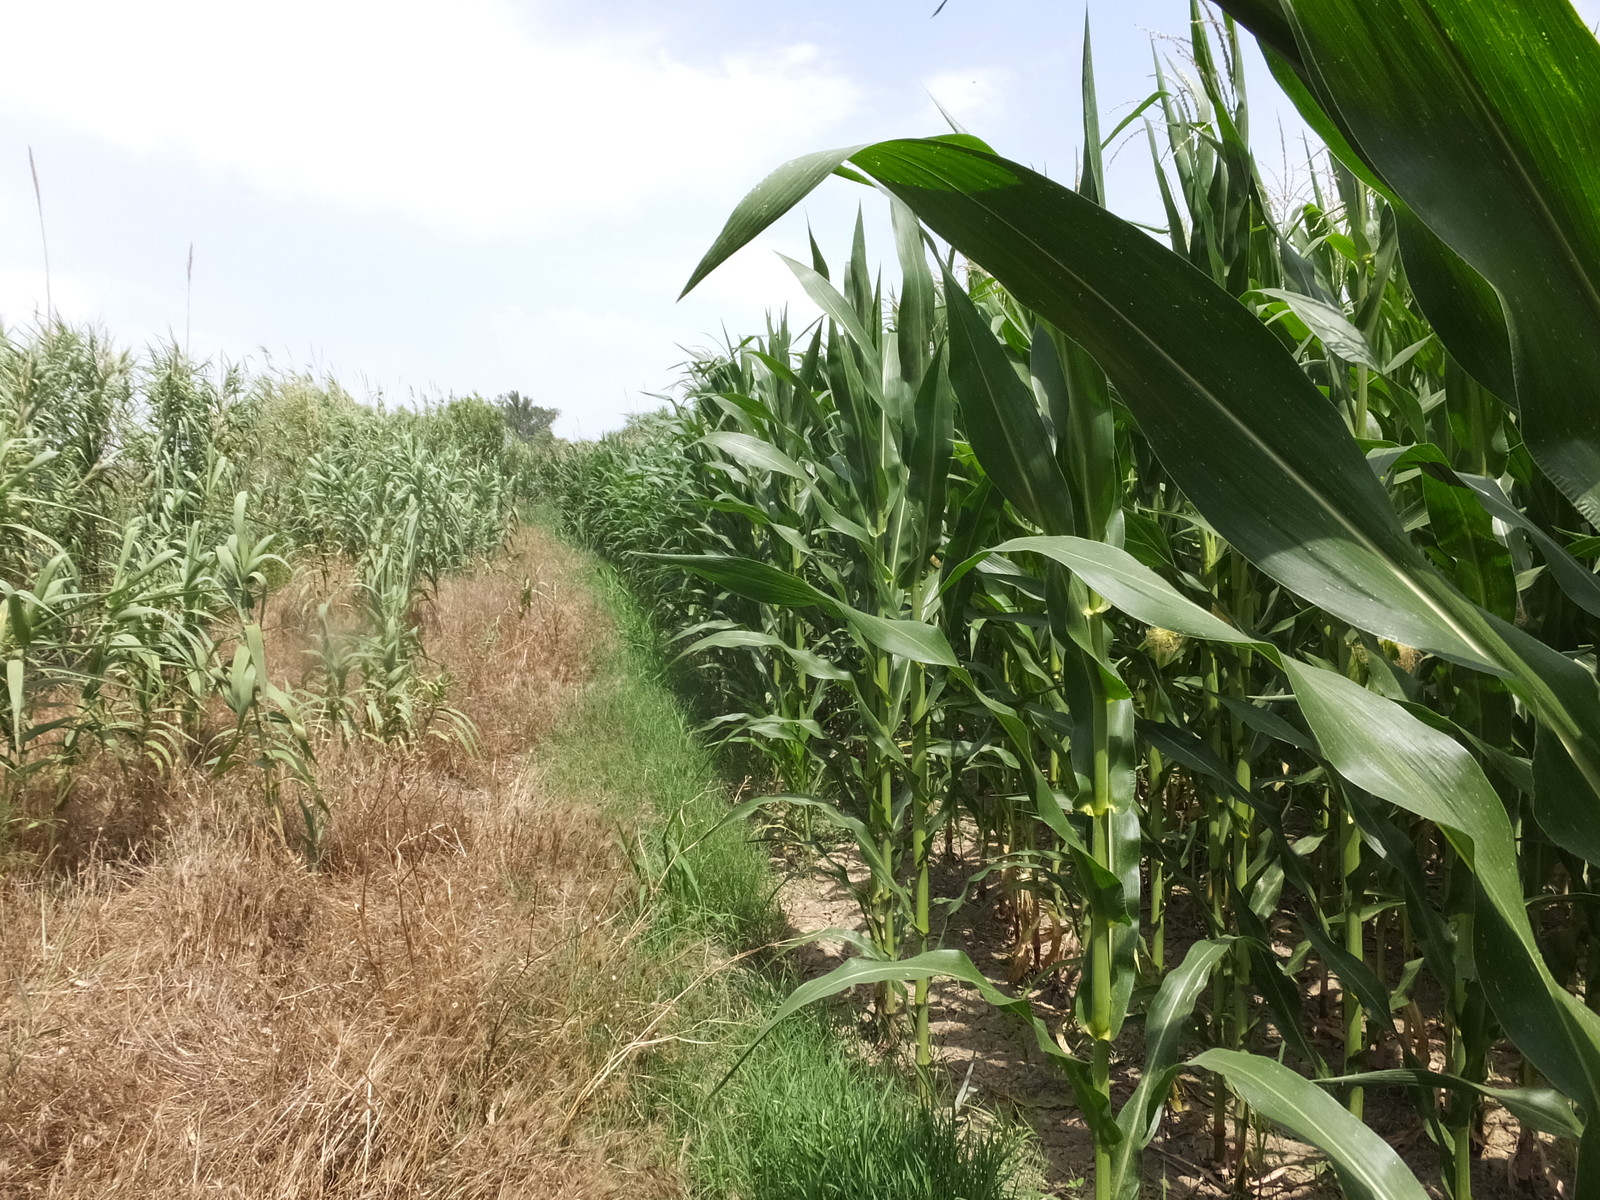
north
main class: Cropland
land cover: Maize
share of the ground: > 75 %
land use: Agriculture (excluding fallow land and kitchen gardens)
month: July
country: ES
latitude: 41.7351
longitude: 0.1374
